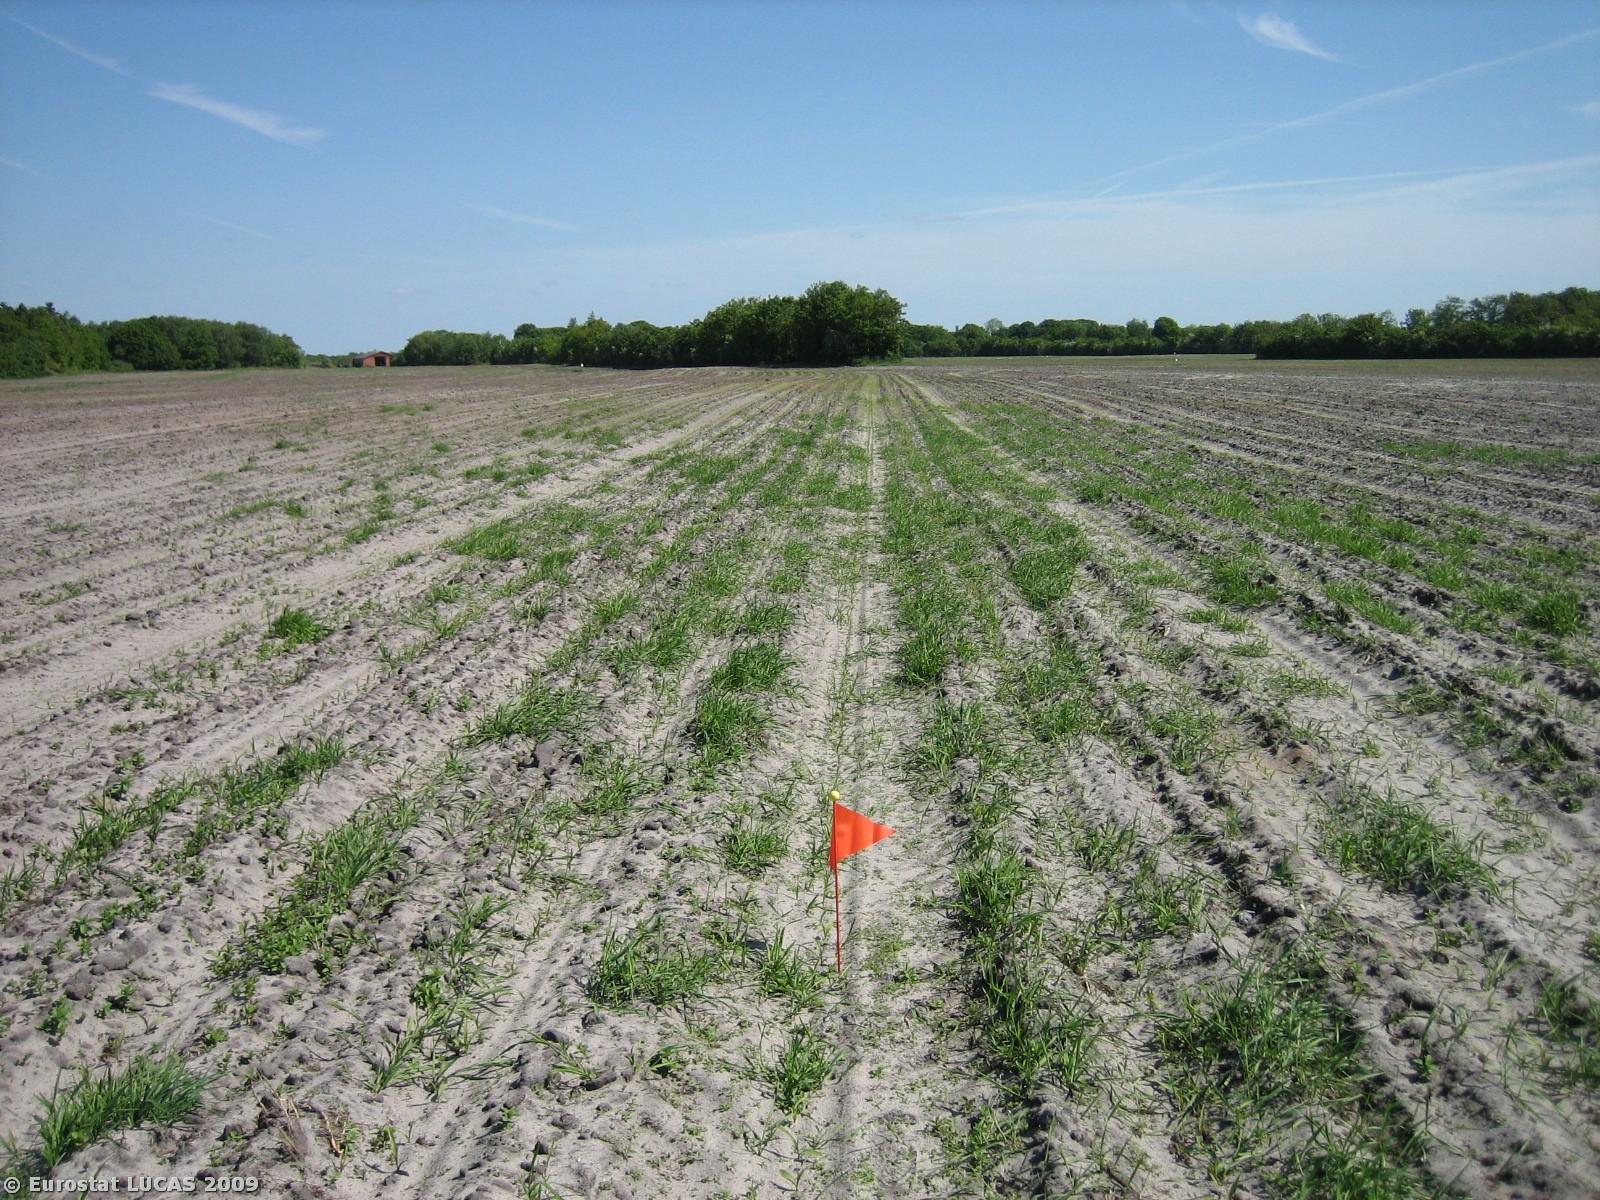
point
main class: Cropland
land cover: Maize
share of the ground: < 10 %
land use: Agriculture (excluding fallow land and kitchen gardens)
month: May
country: DK
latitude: 55.9316
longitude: 8.9287
